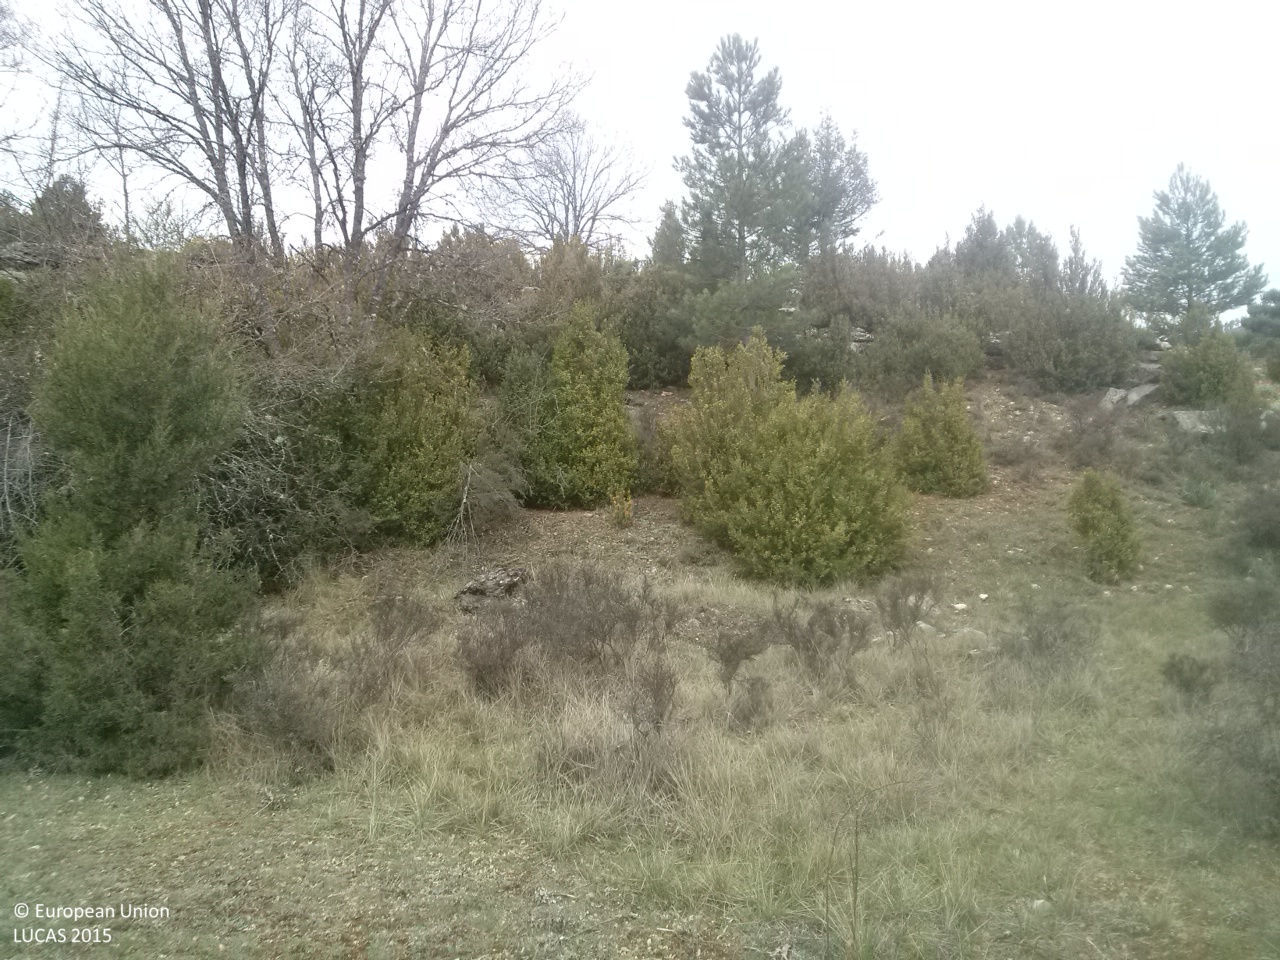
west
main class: Woodland
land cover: Broadleaved woodland
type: mesophytic deciduous forest
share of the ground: 25 - 50 %
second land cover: Grassland without tree/shrub cover
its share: 25 - 50 %
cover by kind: herbaceous plants 55 %, broadleaved forest trees 40 %, shrubs 5 %
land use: Forestry
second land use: Agriculture (excluding fallow land and kitchen gardens)
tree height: > 5 m
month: April
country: ES
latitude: 40.2111
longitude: -1.9414
